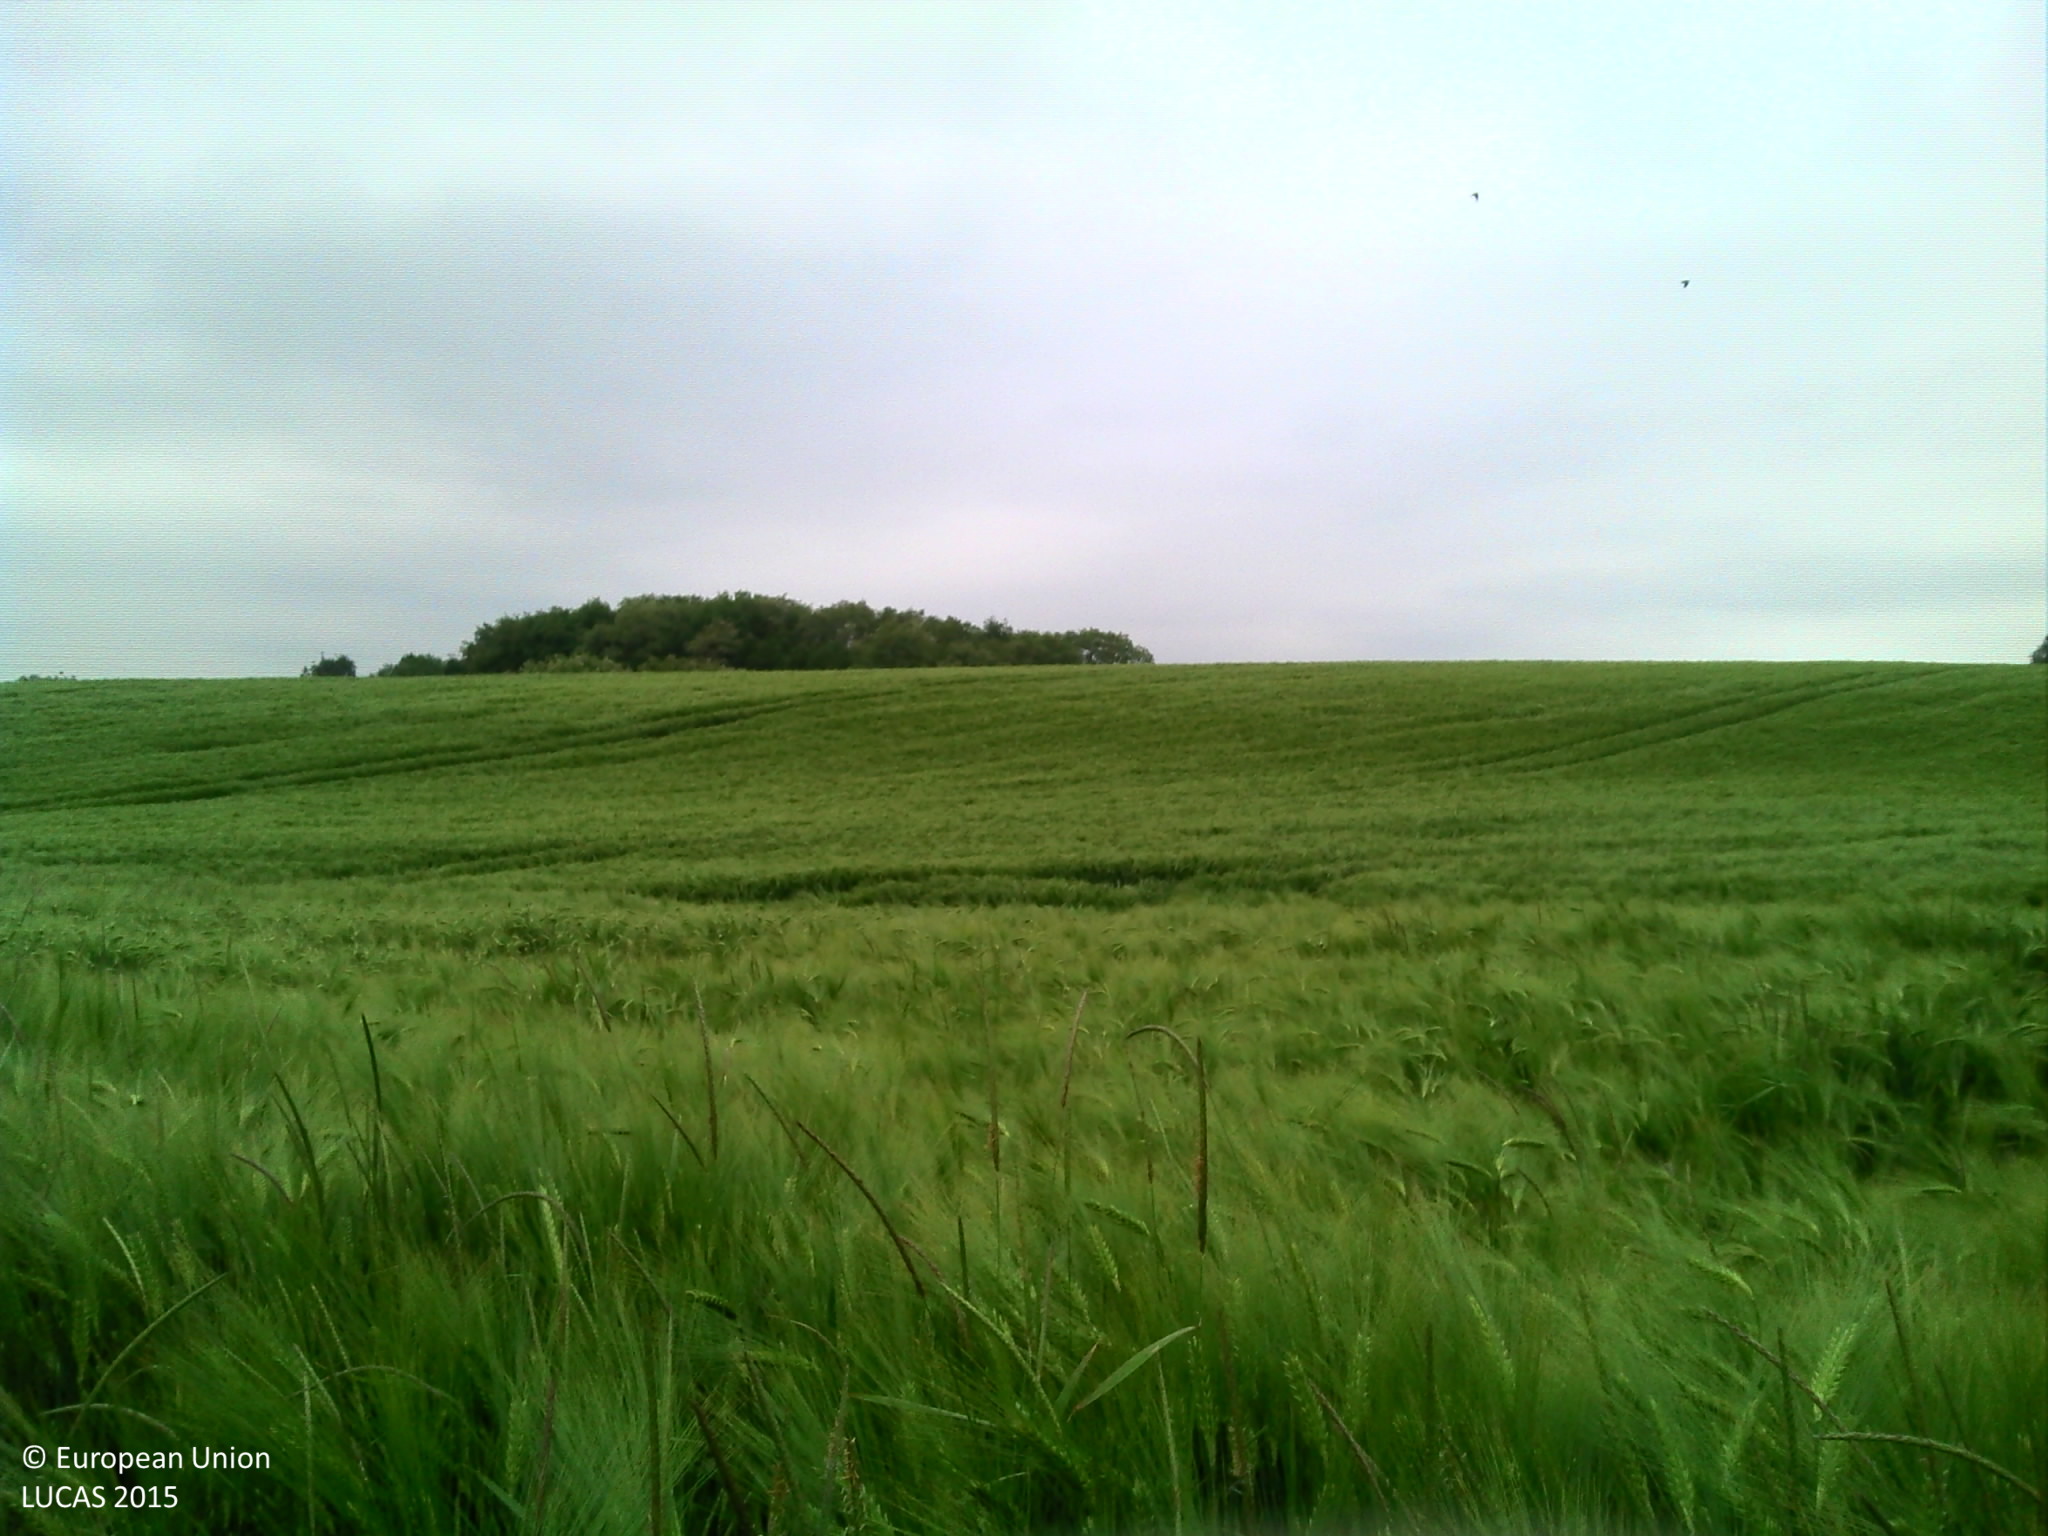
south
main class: Cropland
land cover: Barley
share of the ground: > 75 %
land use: Agriculture (excluding fallow land and kitchen gardens)
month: May
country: FR
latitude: 47.9026
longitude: 6.1080
